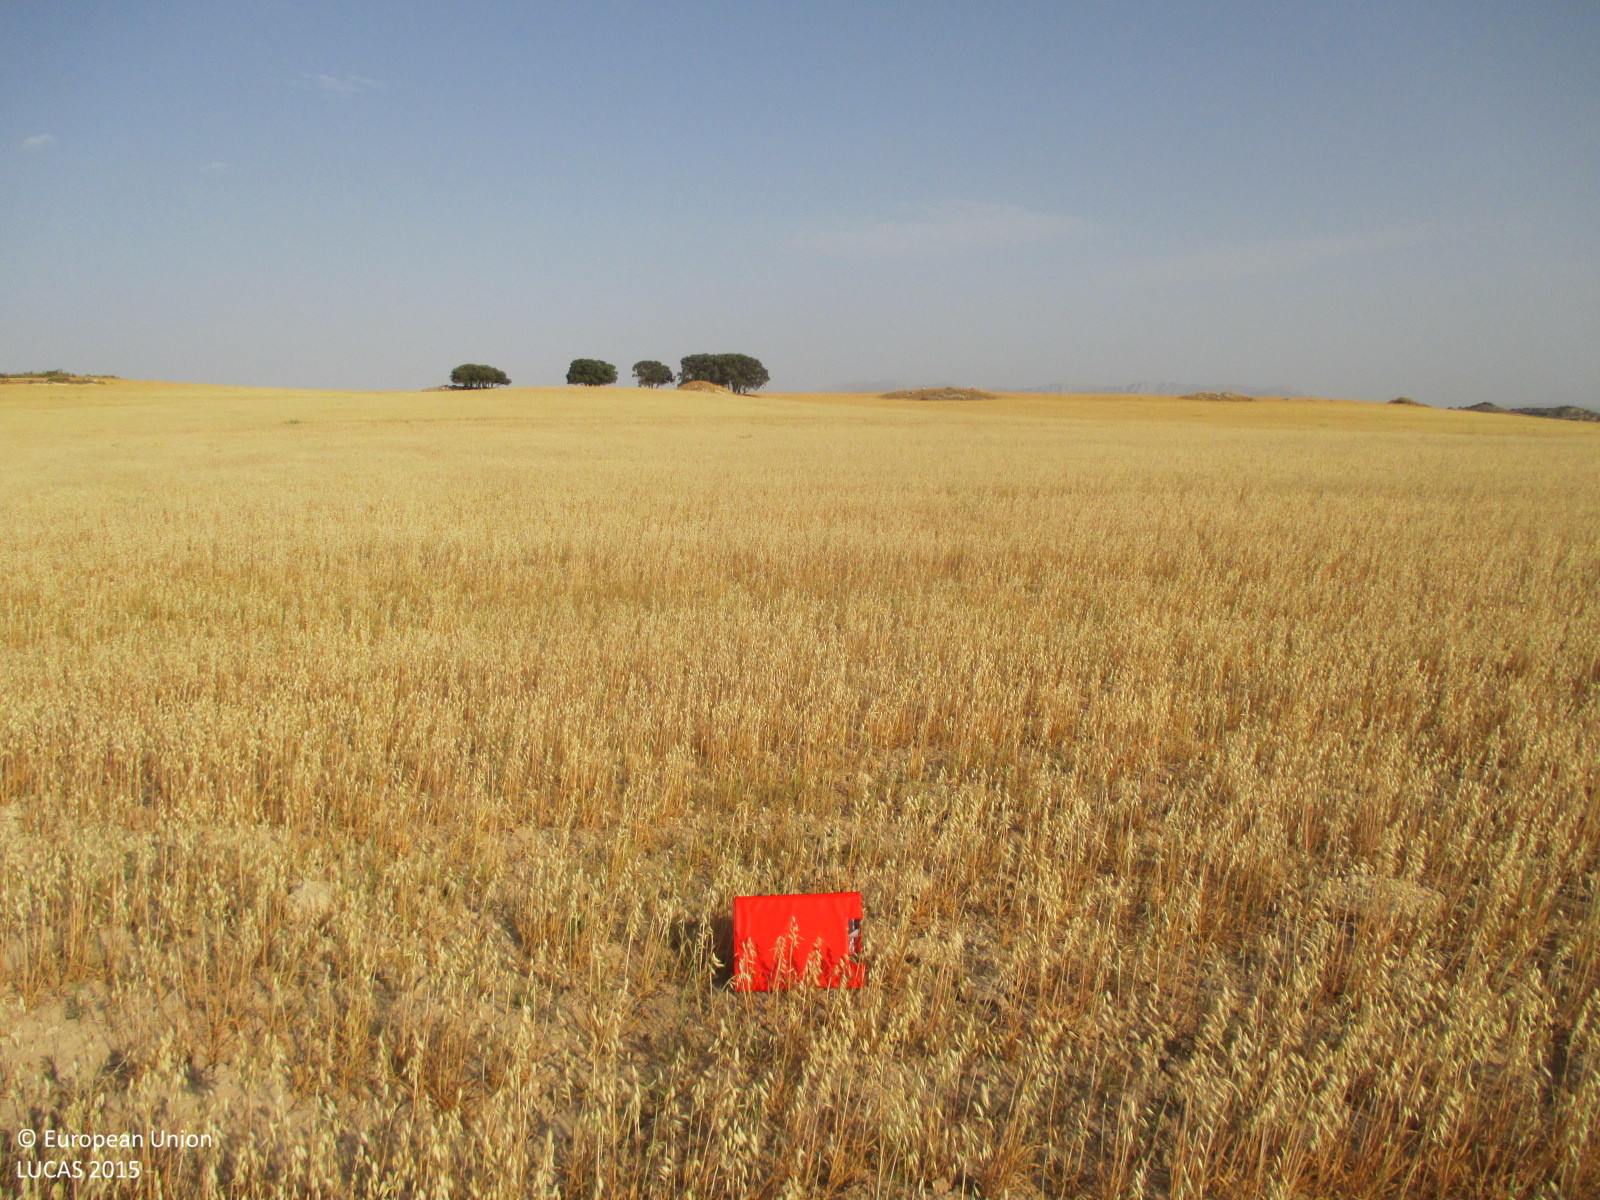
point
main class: Cropland
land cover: Oats
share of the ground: 25 - 50 %
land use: Agriculture (excluding fallow land and kitchen gardens)
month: July
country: ES
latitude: 37.8353
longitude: -2.3628
